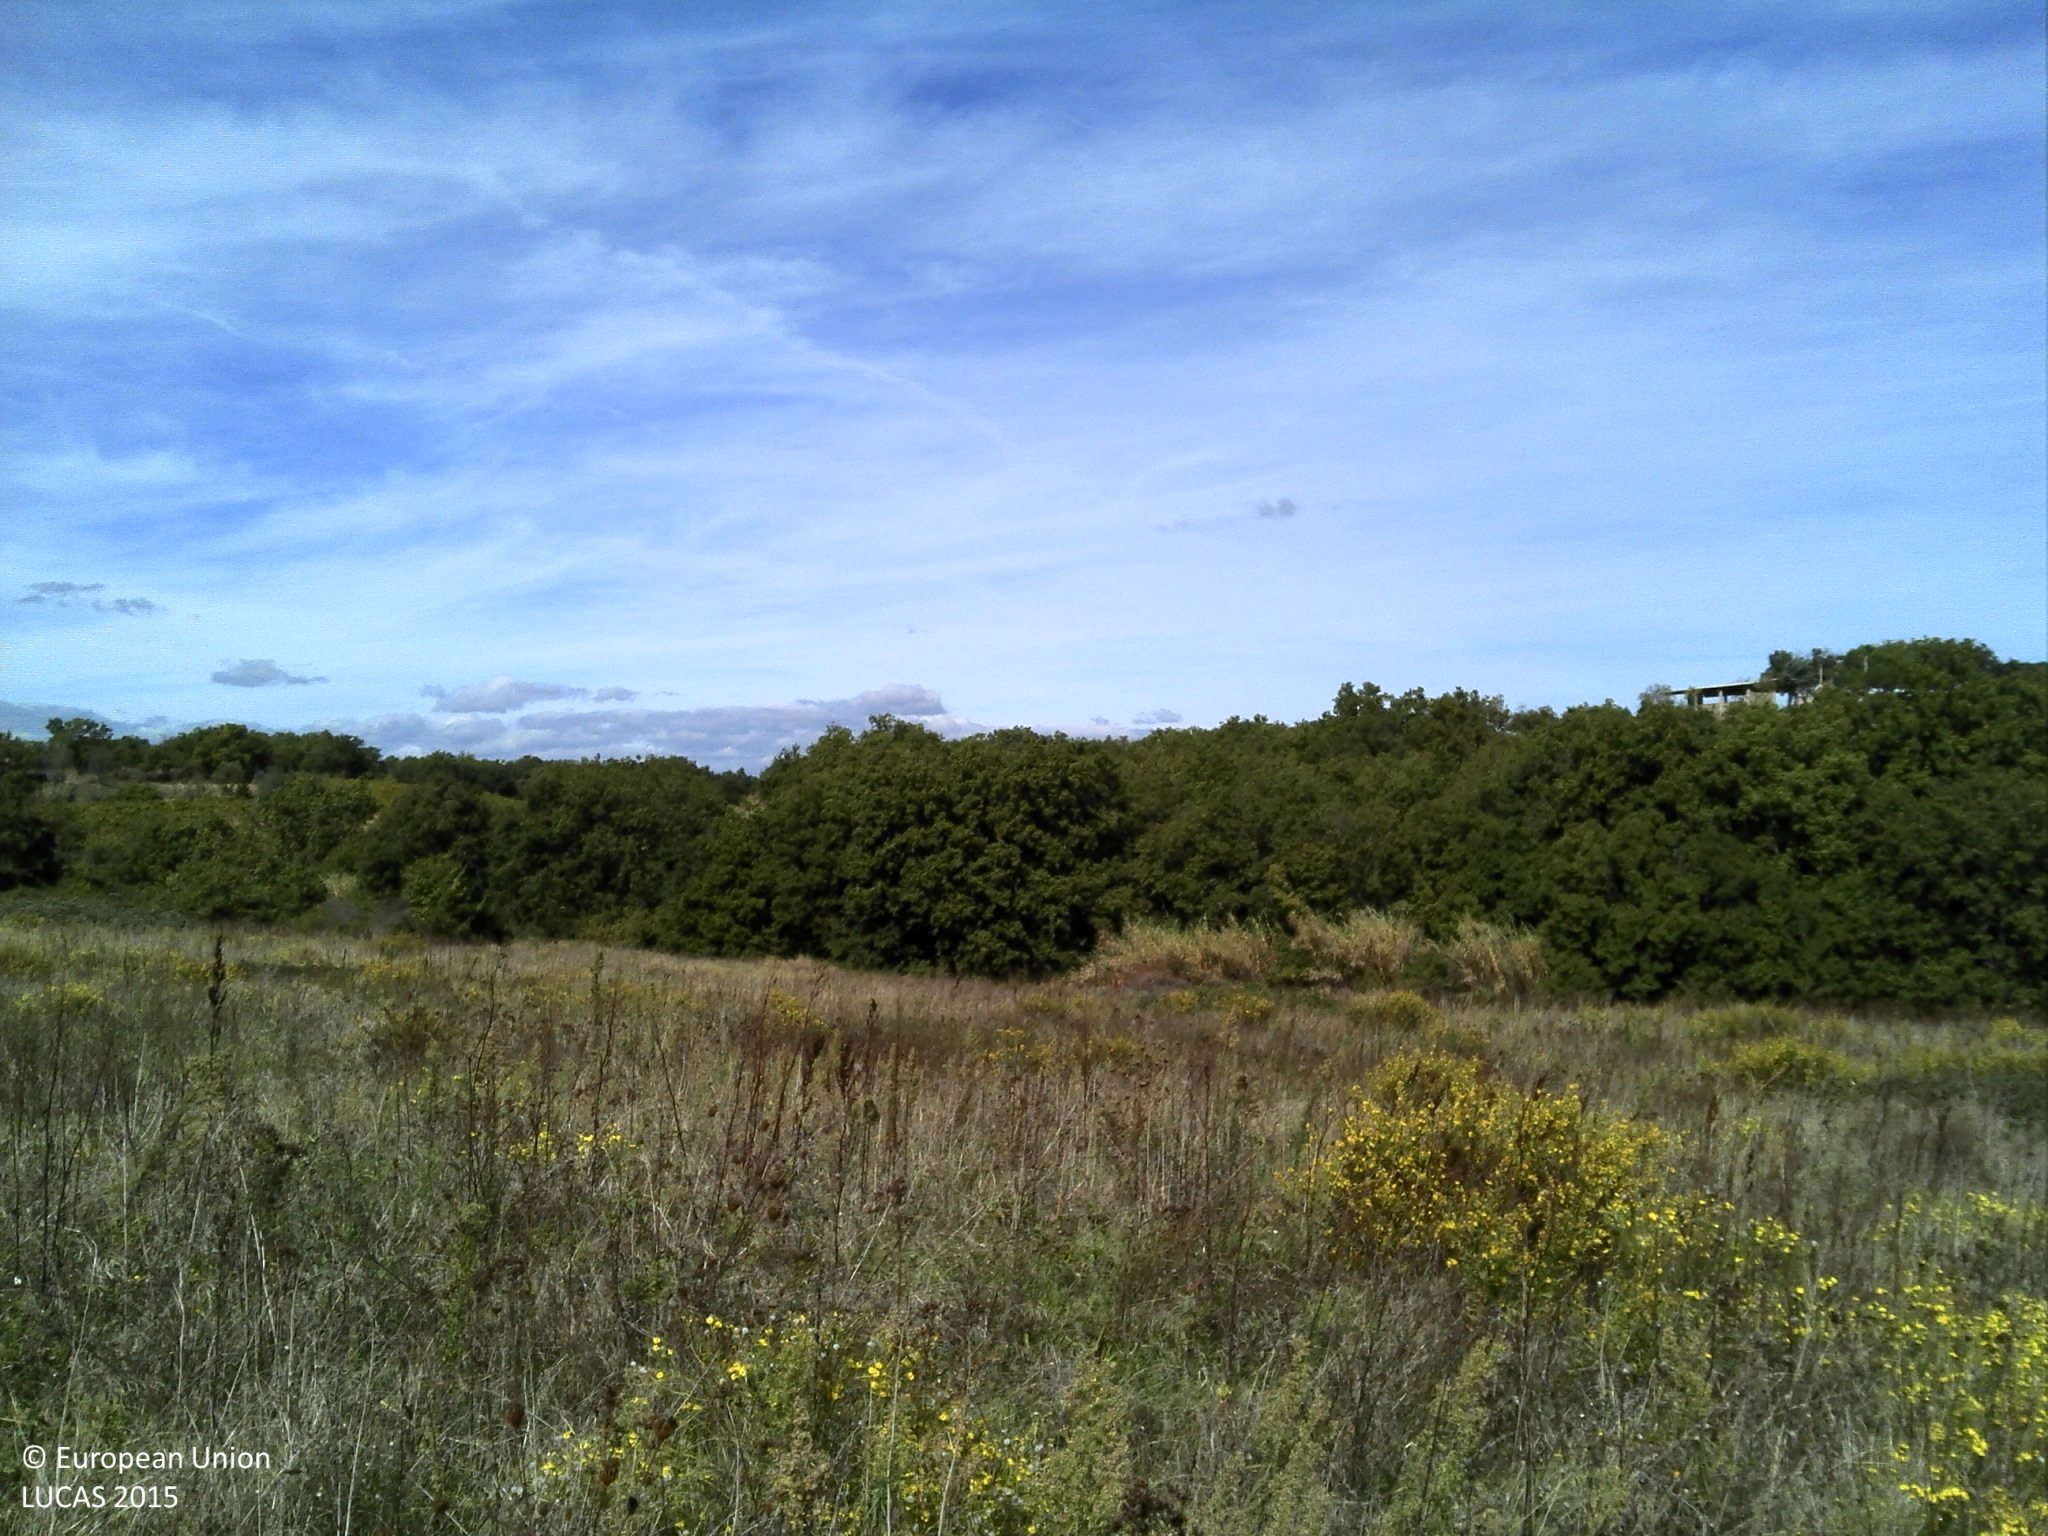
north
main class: Grassland
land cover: Spontaneously vegetated surfaces
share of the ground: > 75 %
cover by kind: herbaceous plants 95 %, shrubs 5 %
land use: Semi-natural and natural areas not in use
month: October
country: FR
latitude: 43.3858
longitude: 3.2075
